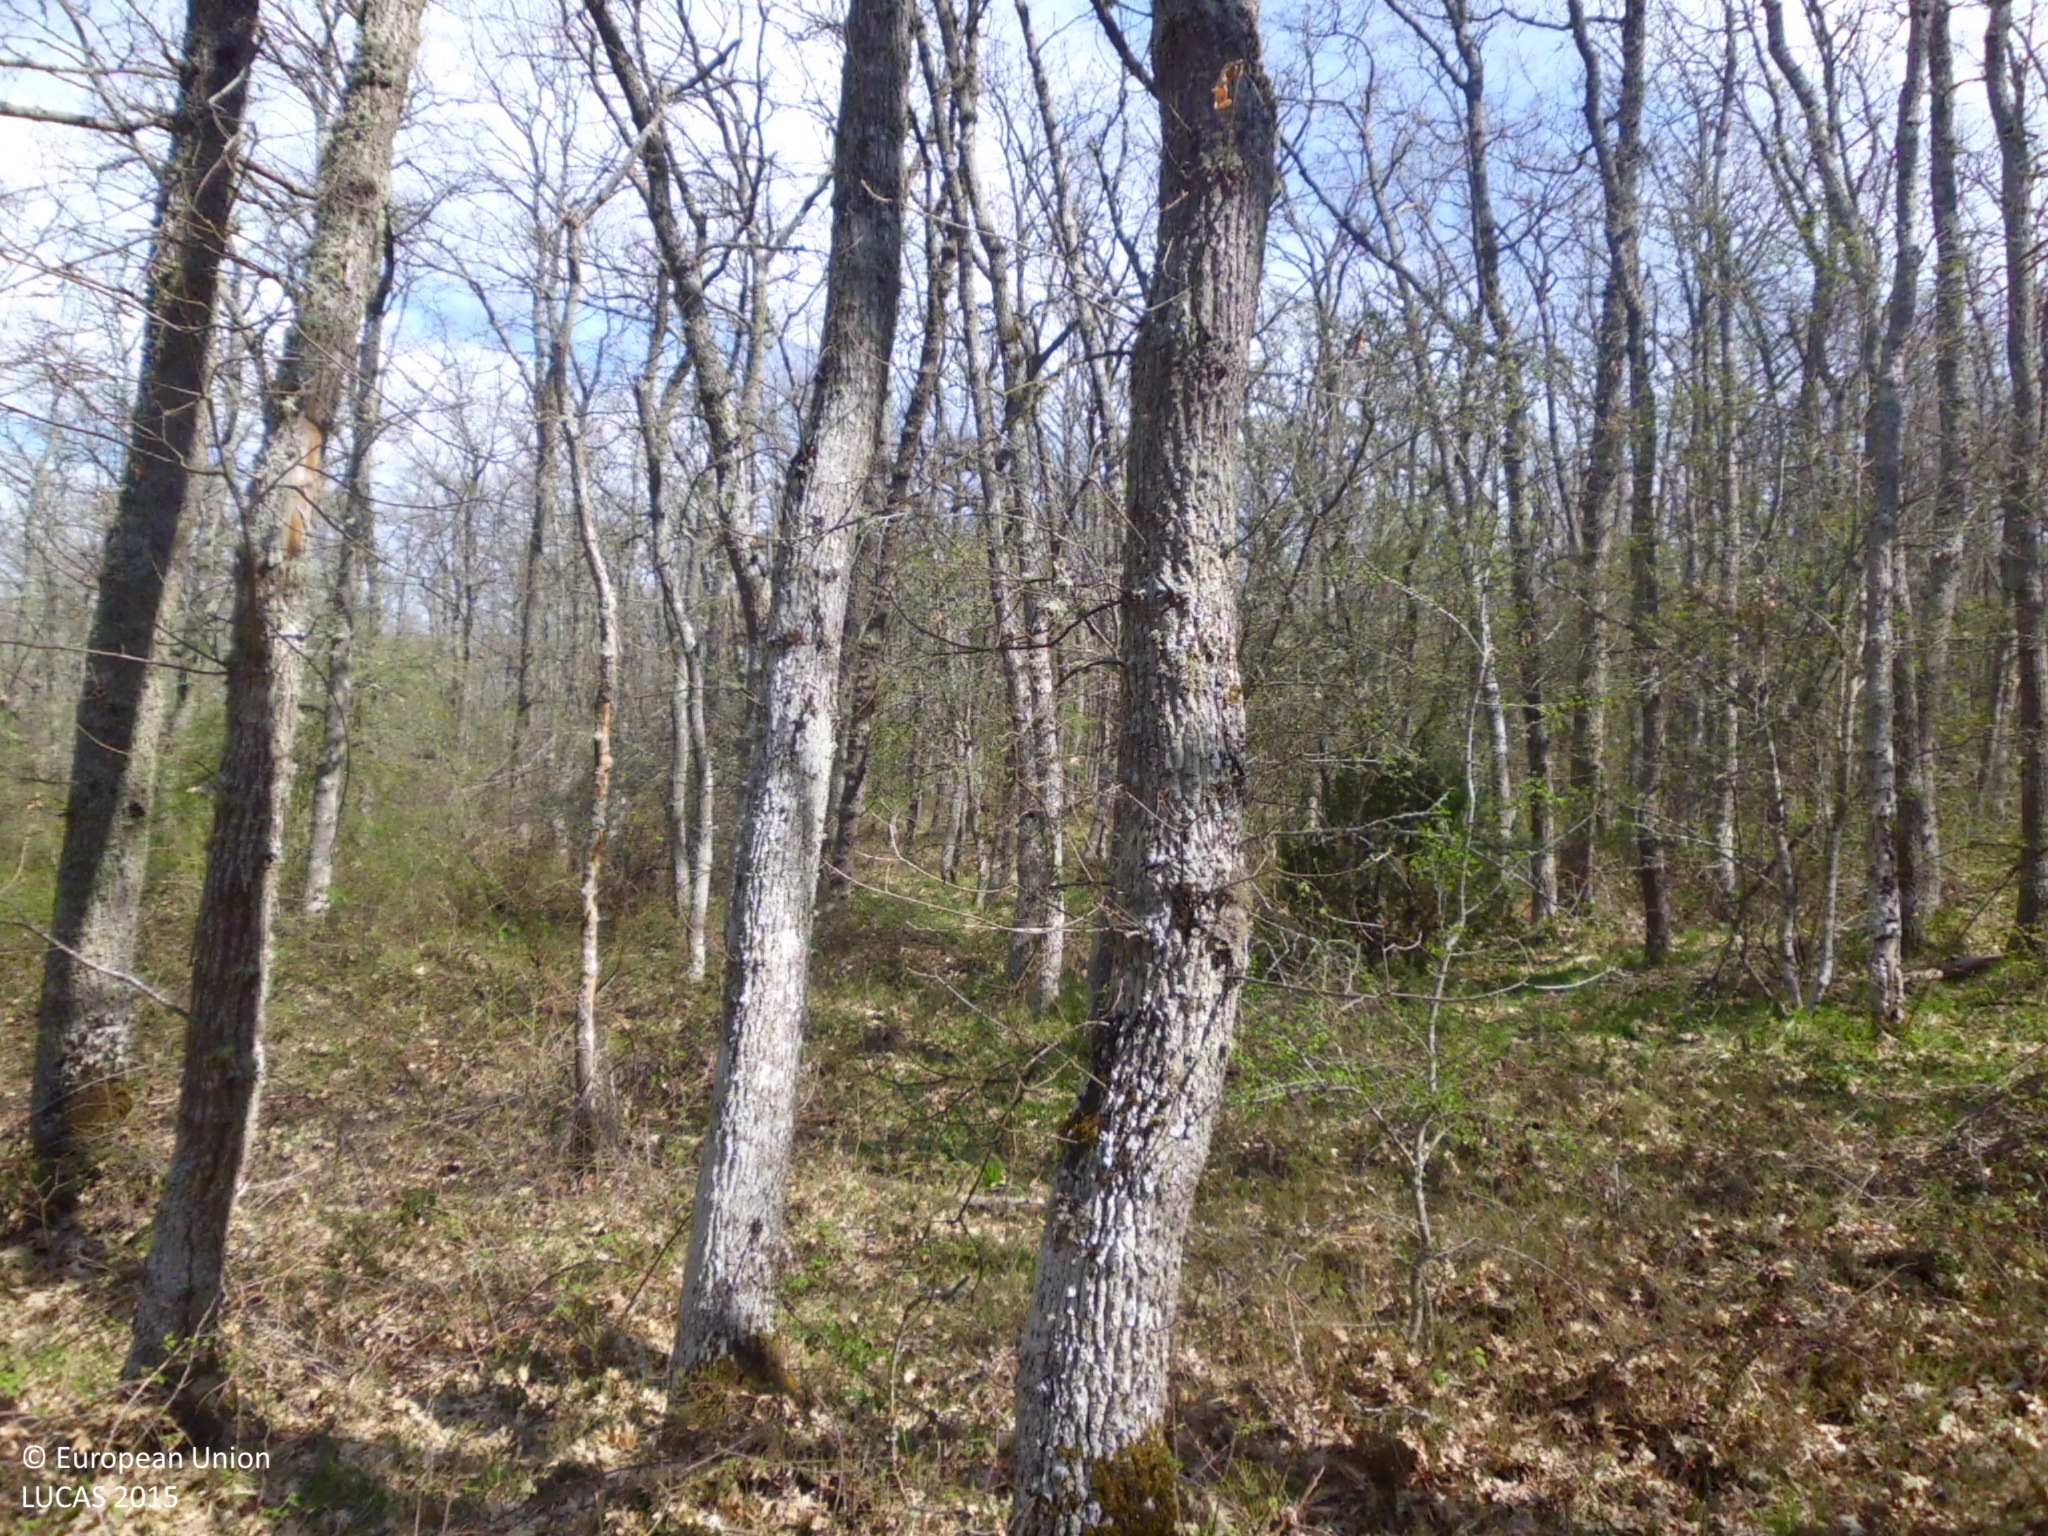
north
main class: Woodland
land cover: Broadleaved woodland
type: acidophilous oak and oak-birch forest
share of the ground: > 75 %
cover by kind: broadleaved forest trees 95 %, herbaceous plants 5 %
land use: Semi-natural and natural areas not in use
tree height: > 5 m
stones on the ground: < 10 %
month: April
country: ES
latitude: 42.4010
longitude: -3.3844
